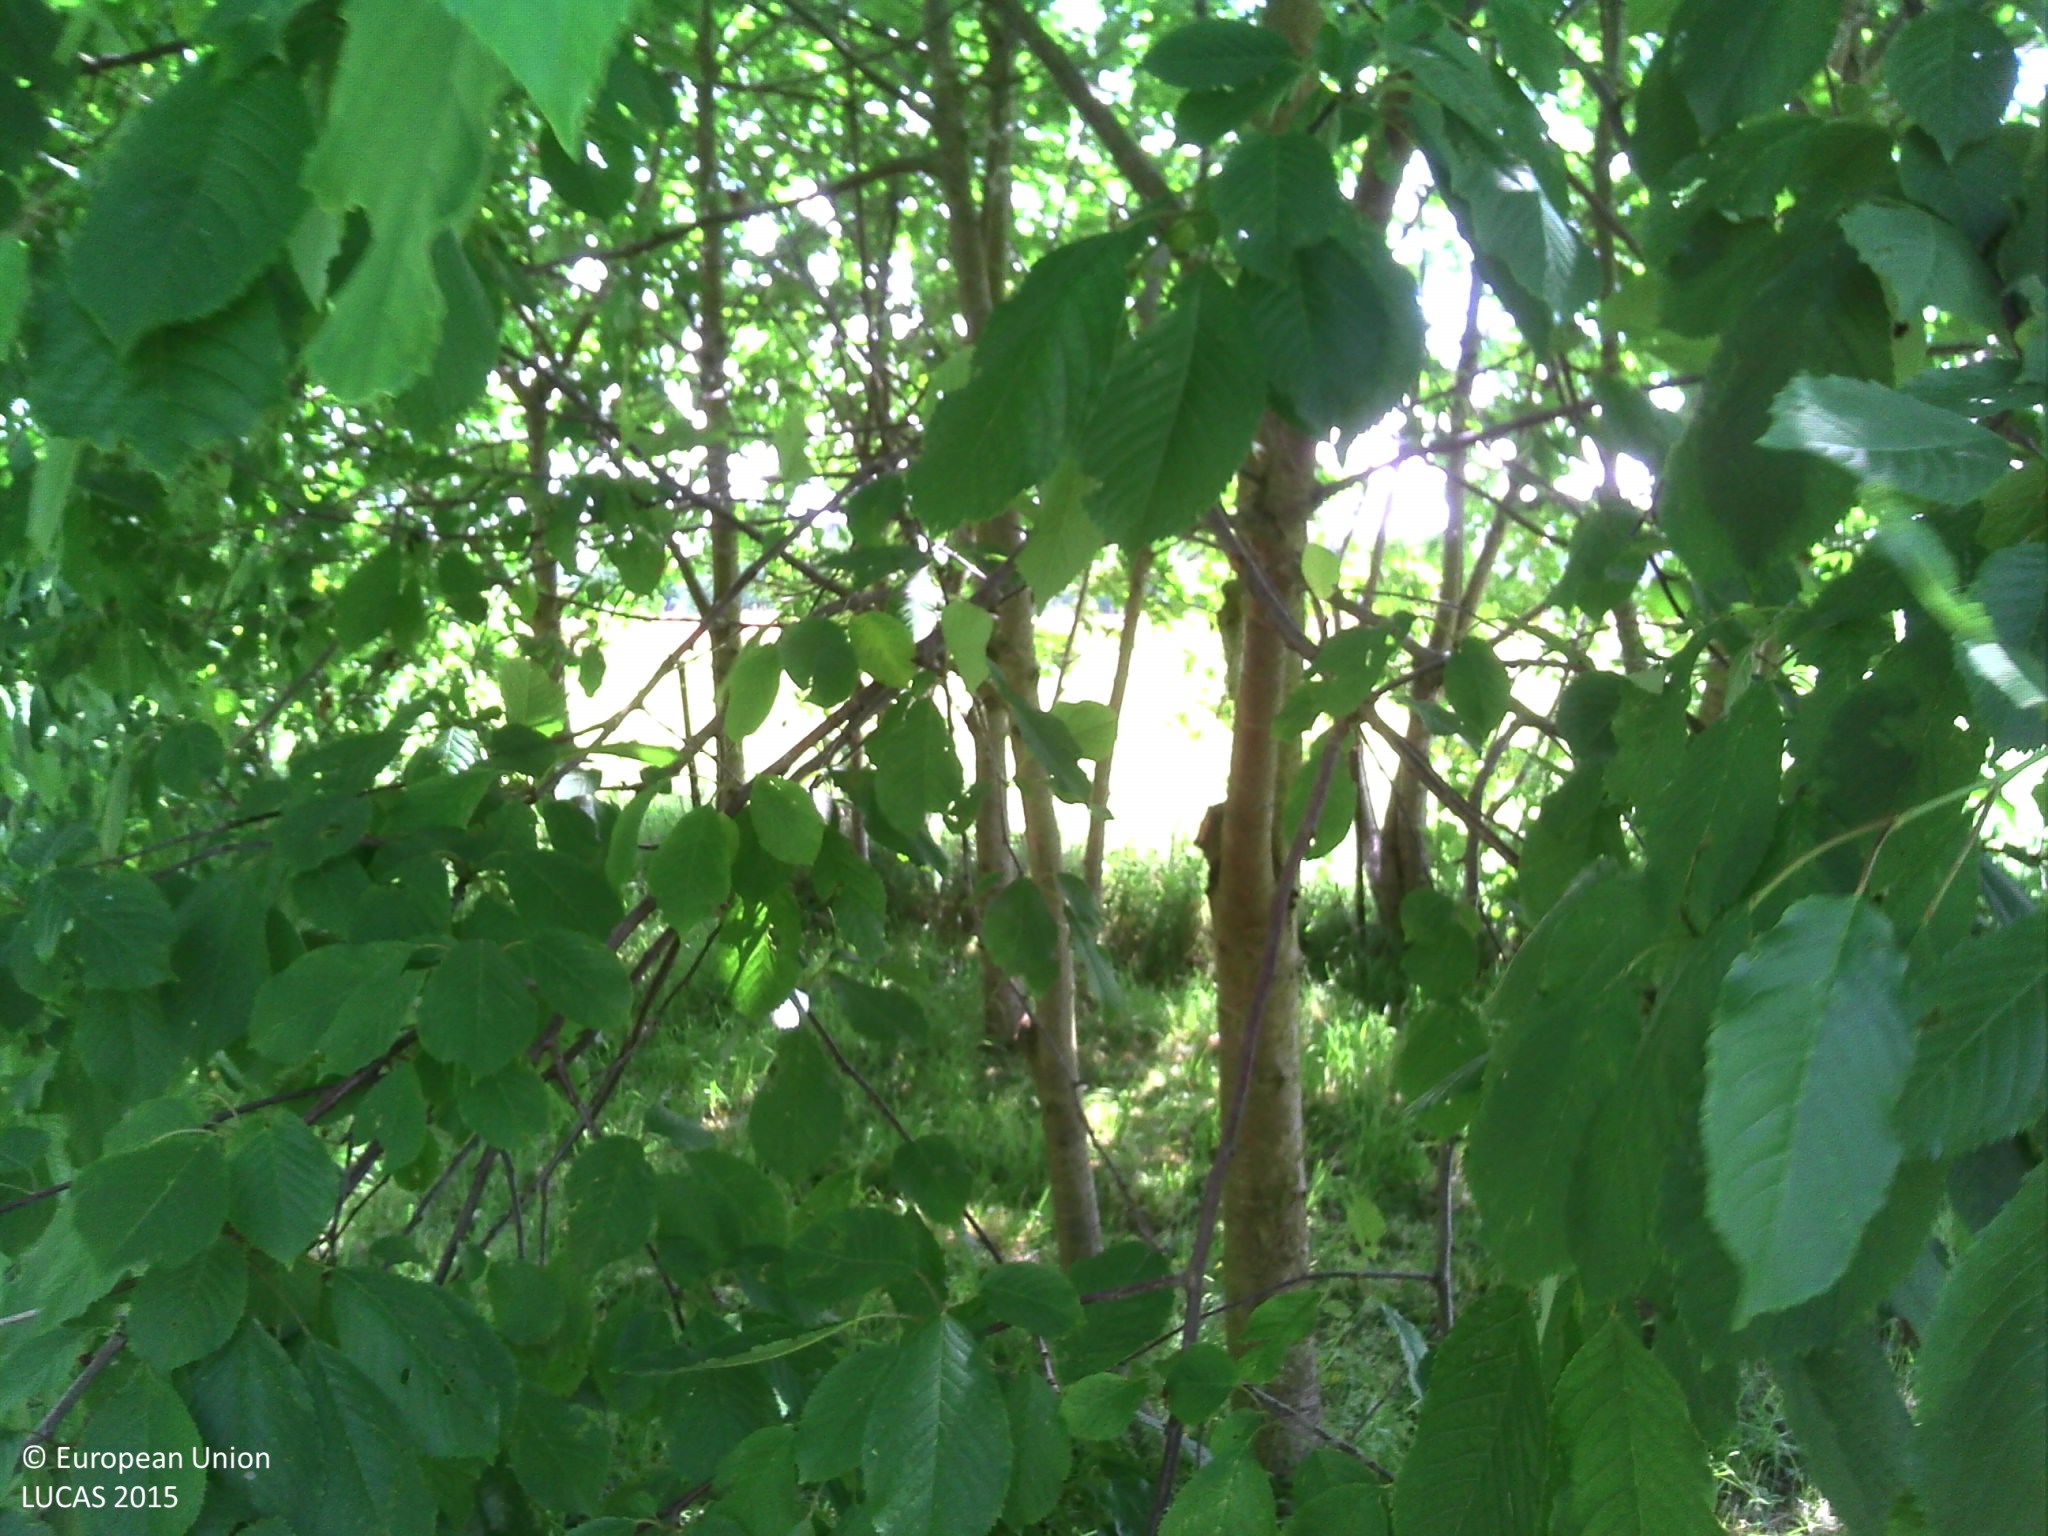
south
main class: Woodland
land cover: Broadleaved woodland
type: exotic forest
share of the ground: > 75 %
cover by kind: broadleaved forest trees 100 %
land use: Forestry
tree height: > 5 m
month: June
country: BE
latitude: 50.7456
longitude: 3.6295
